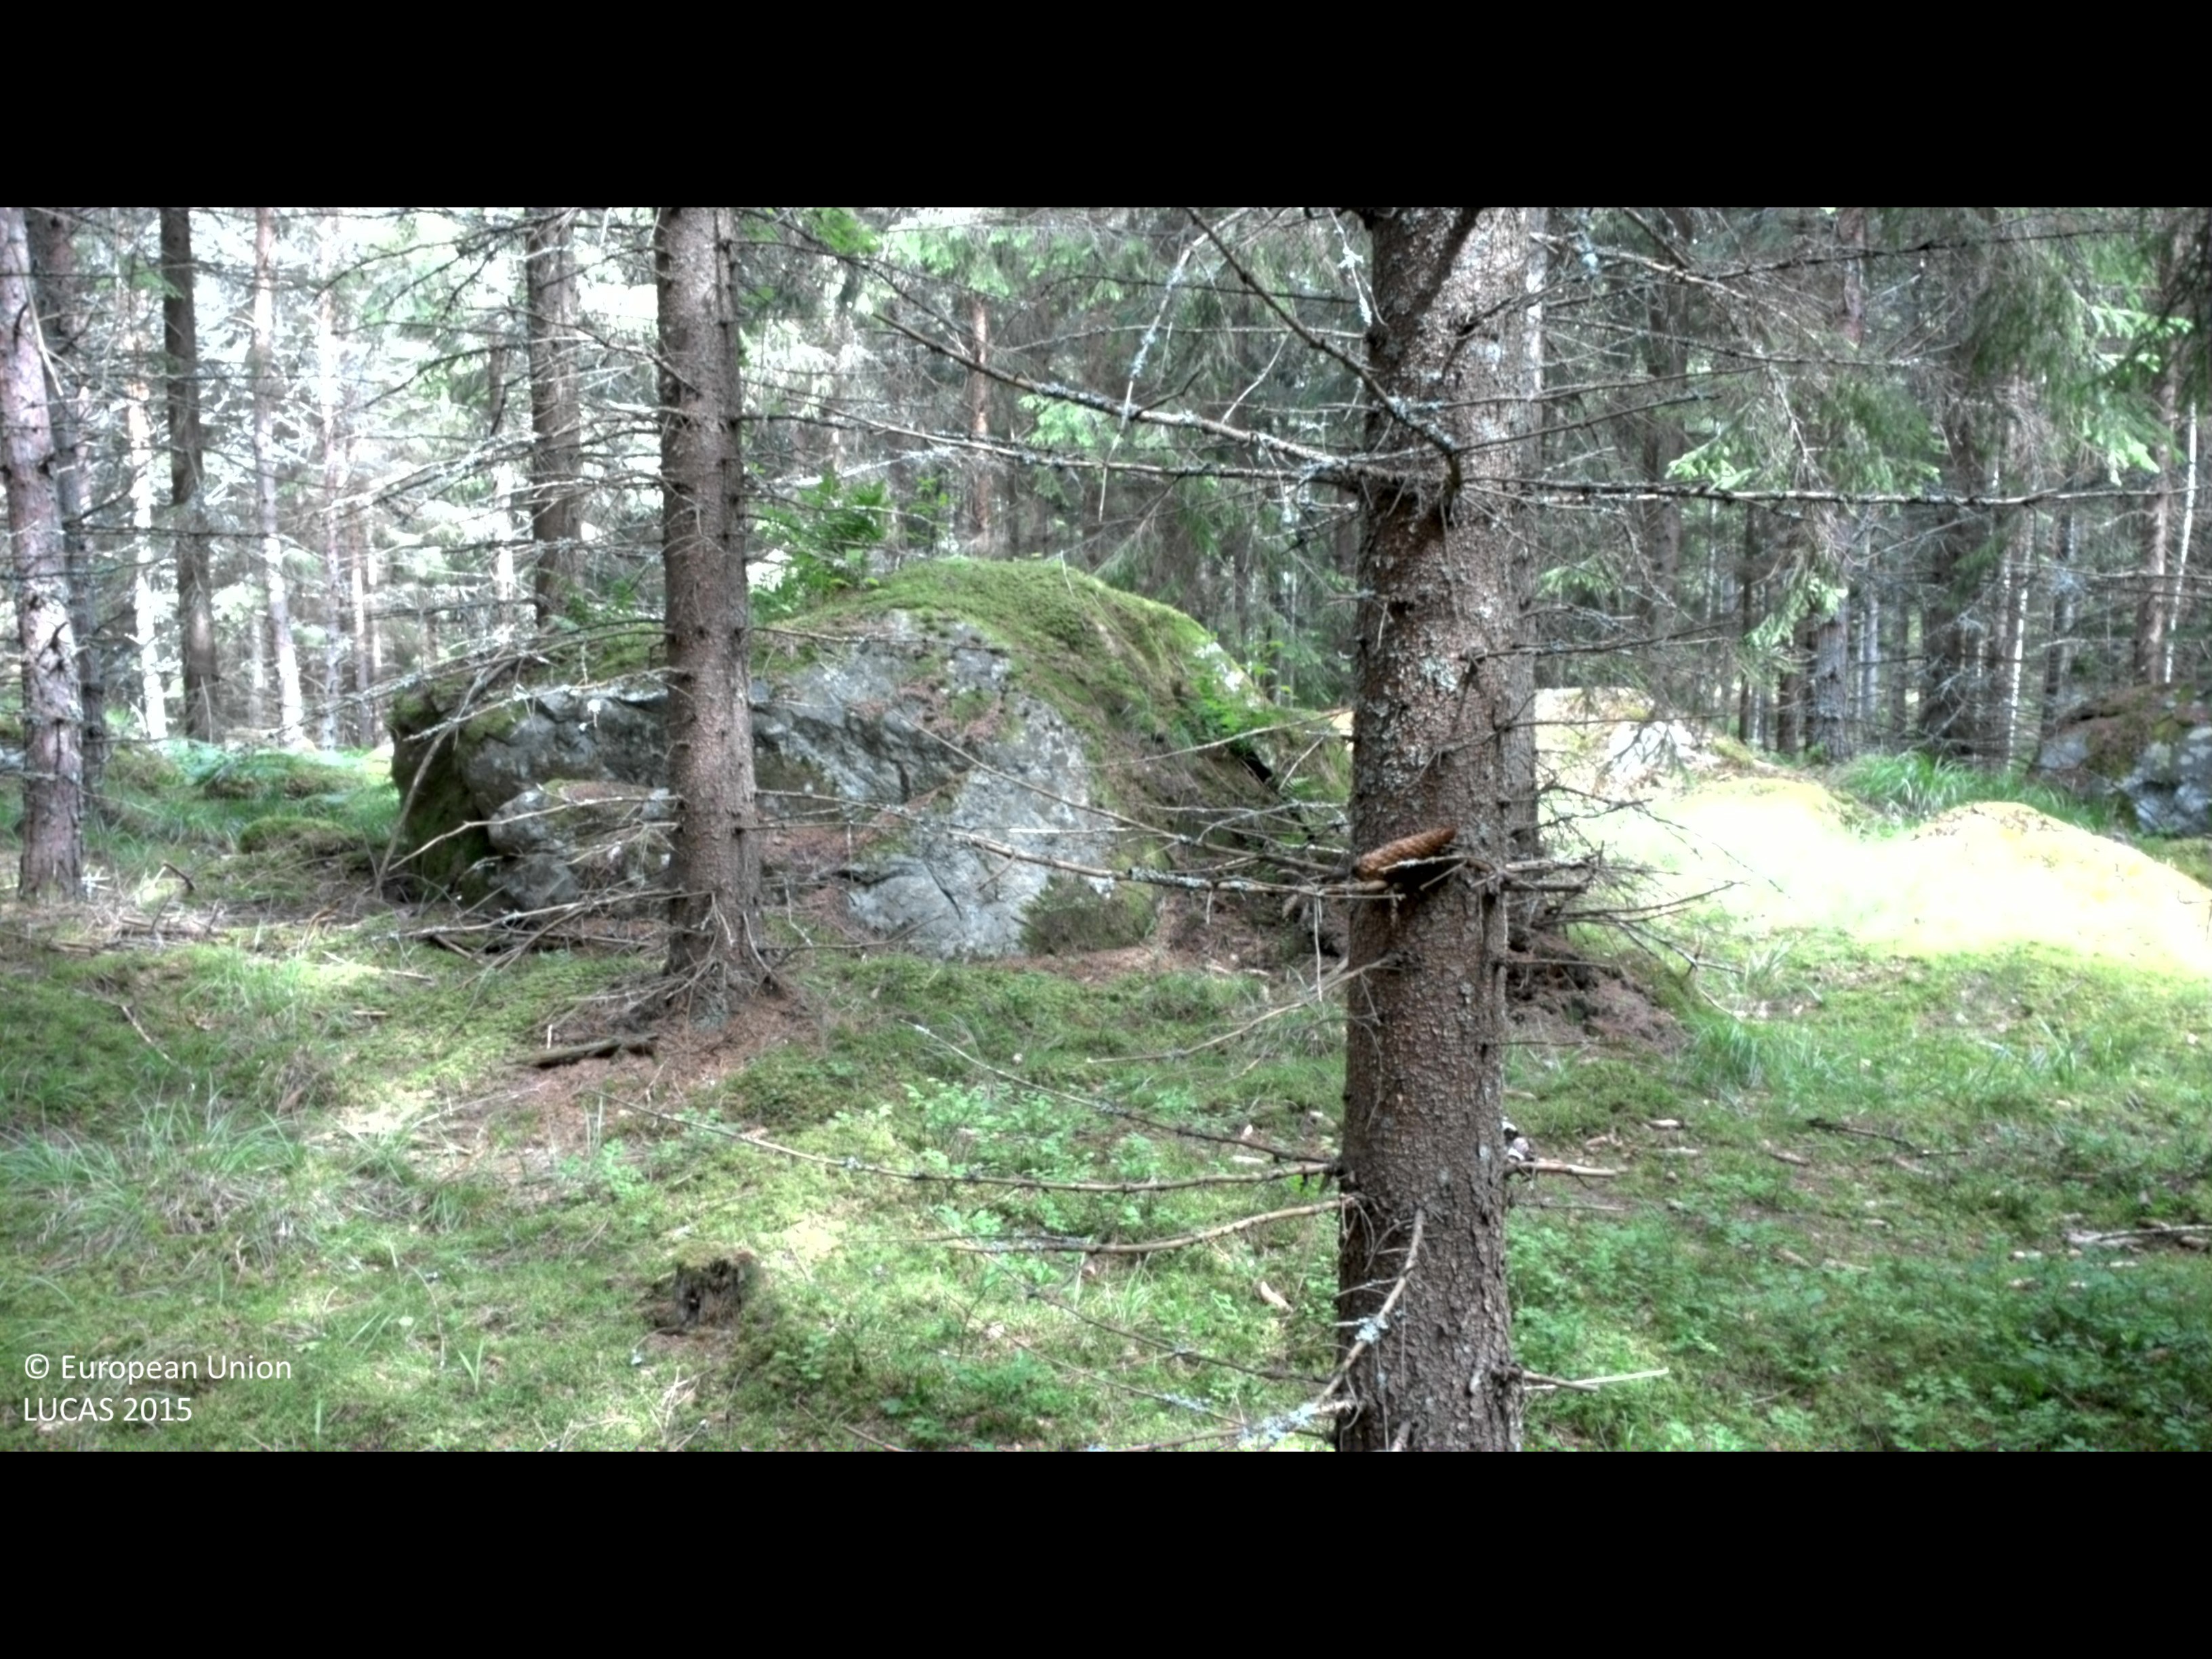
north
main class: Woodland
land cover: Spruce dominated coniferous woodland
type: boreal forest
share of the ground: > 75 %
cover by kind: coniferous forest trees 70 %, broadleaved forest trees 15 %, lichens and mosses 10 %, shrubs 5 %
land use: Forestry
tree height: > 5 m
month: June
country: SE
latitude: 58.2430
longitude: 16.1115
